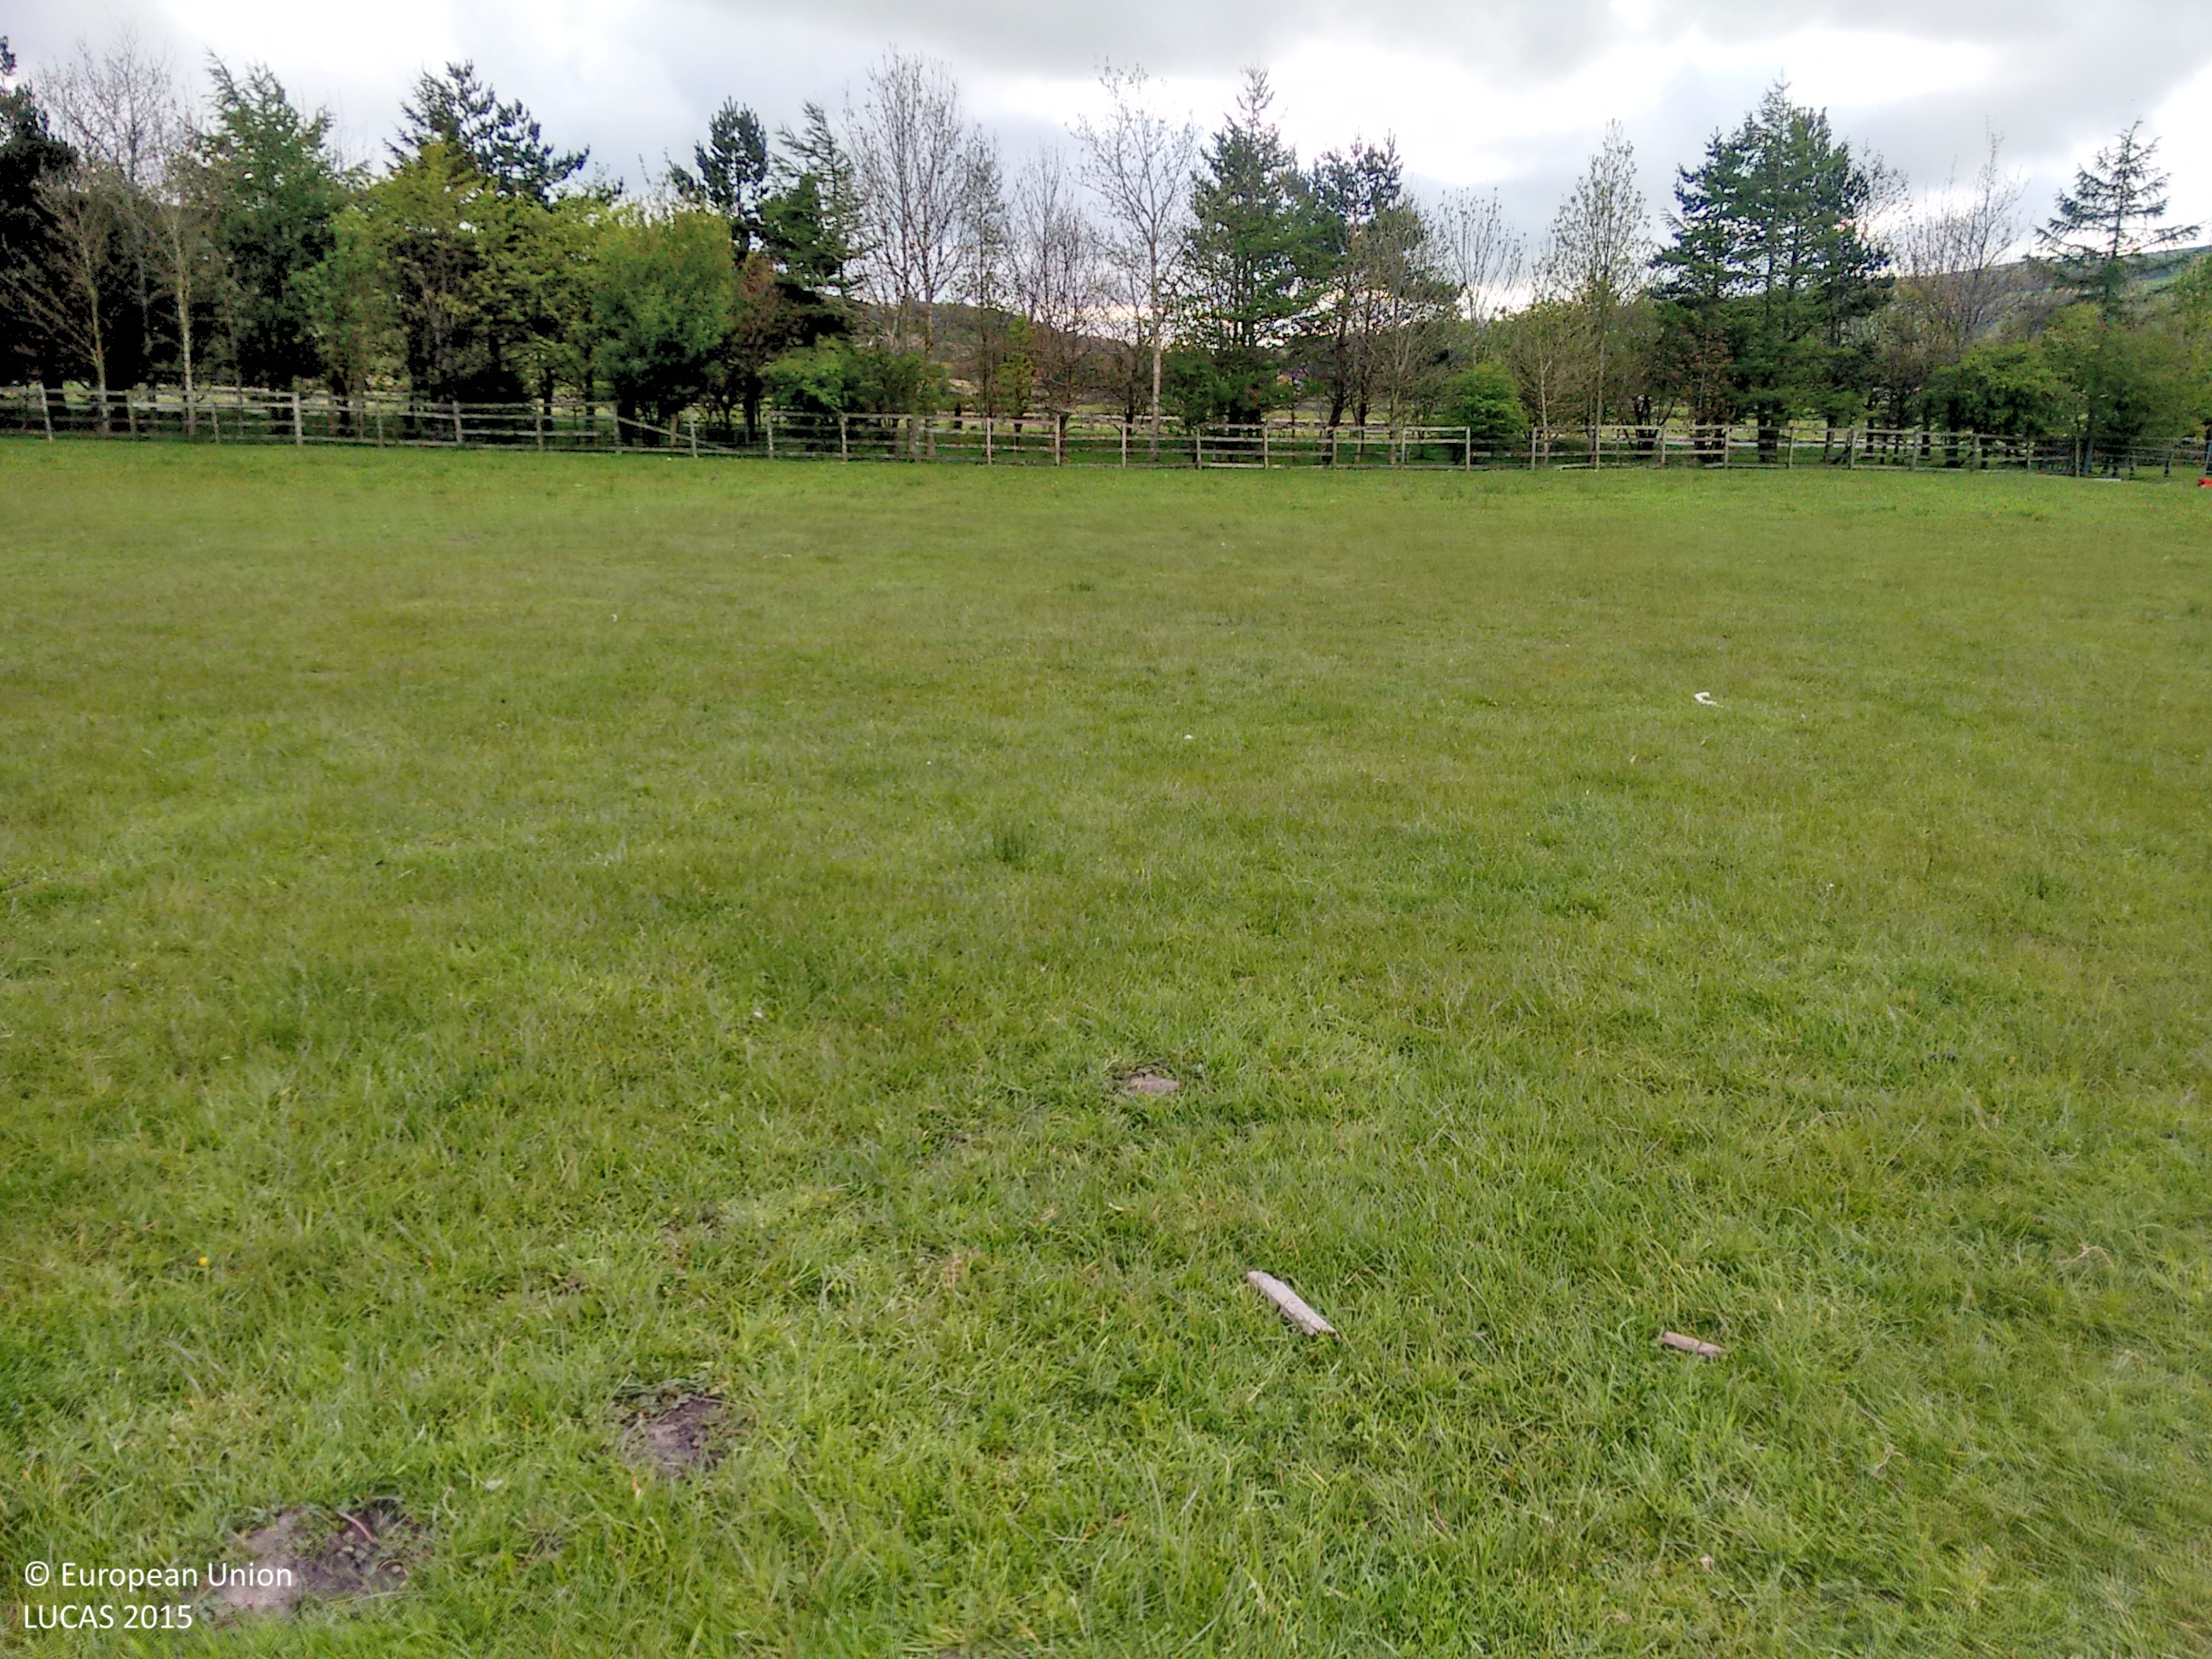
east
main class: Grassland
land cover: Grassland without tree/shrub cover
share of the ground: > 75 %
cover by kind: herbaceous plants 100 %
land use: Agriculture (excluding fallow land and kitchen gardens)
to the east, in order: Grassland without tree/shrub cover; Fences; Broadleaved woodland; Grass margins; Paved roads, cycling and walking lanes; Grass margins; Fences; Grassland without tree/shrub cover; Dry stone walls; Grassland without tree/shrub cover; Electric lines; Grassland without tree/shrub cover; Electric lines; Grassland without tree/shrub cover
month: May
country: GB
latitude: 53.5248
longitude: -1.6826
